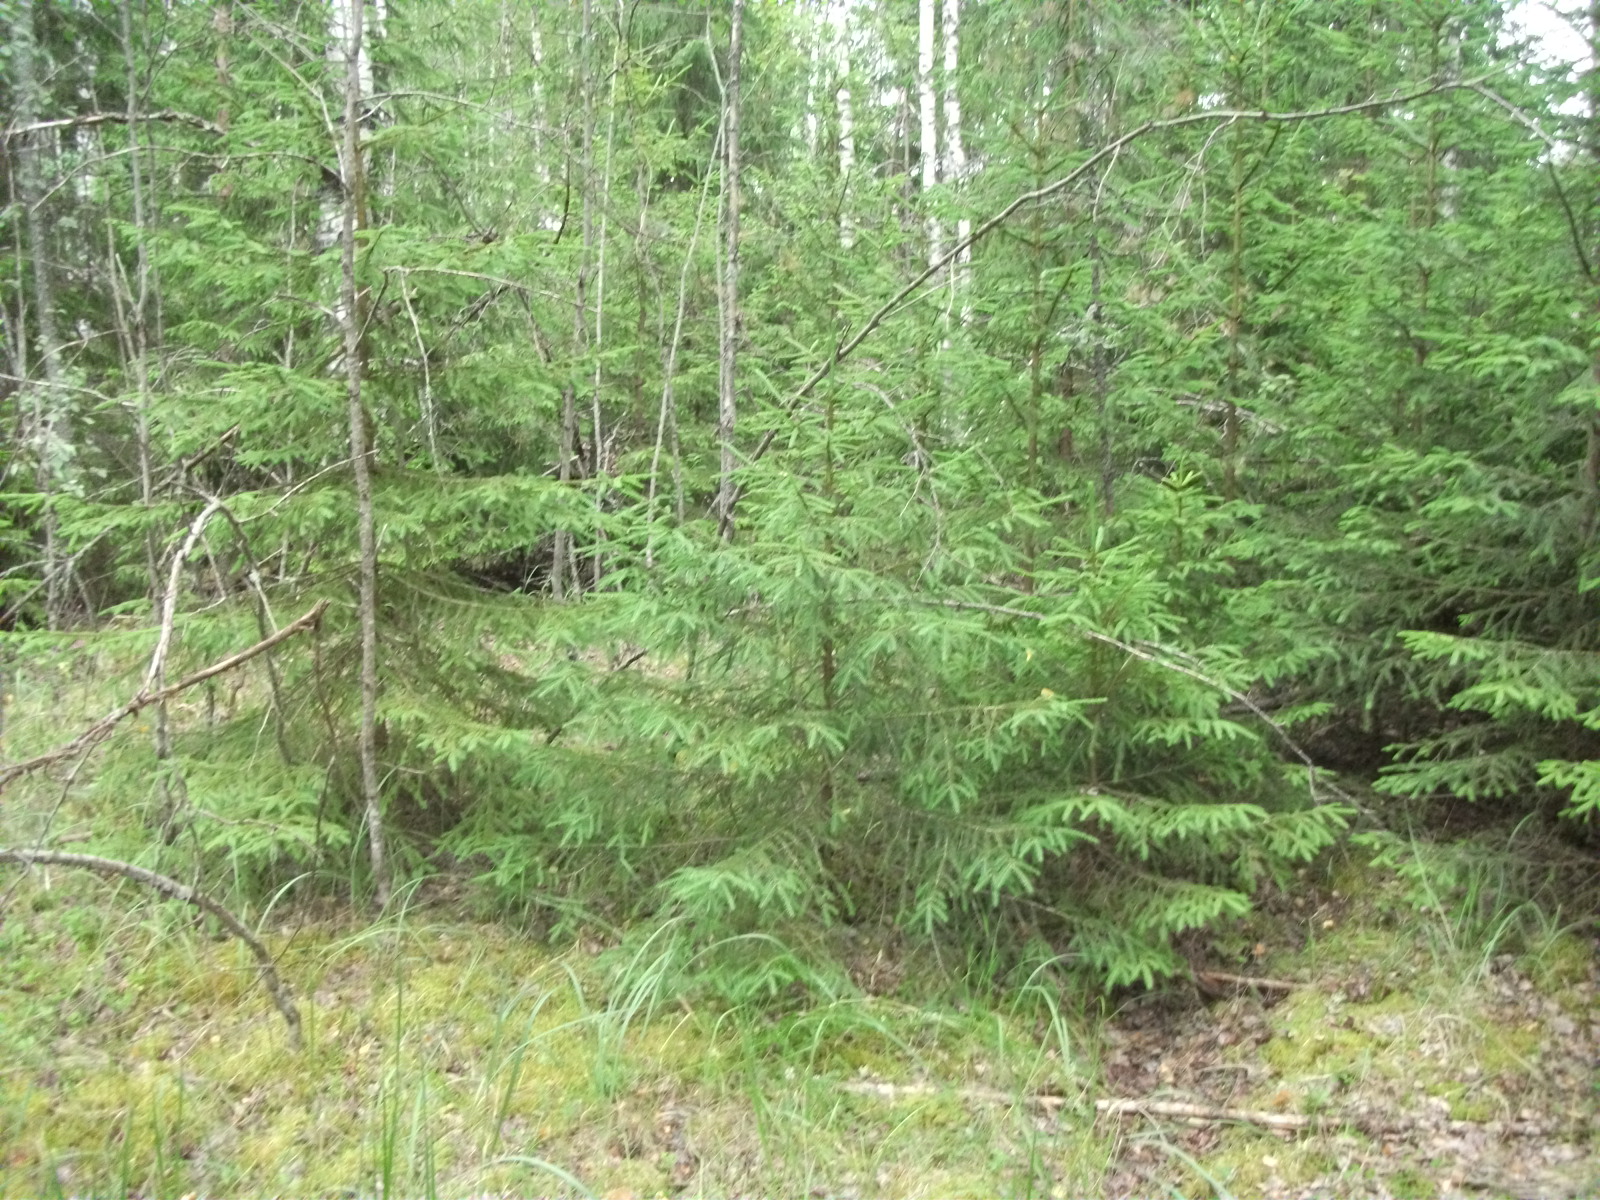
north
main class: Woodland
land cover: Spruce dominated mixed woodland
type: hemiboreal forest and nemoral coniferous forest and mixed broadleaved-coniferous forest
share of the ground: 50 - 75 %
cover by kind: coniferous forest trees 45 %, broadleaved forest trees 25 %, shrubs 10 %, herbaceous plants 10 %, lichens and mosses 10 %
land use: Forestry
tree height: > 5 m
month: July
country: LV
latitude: 57.2182
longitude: 26.5566
